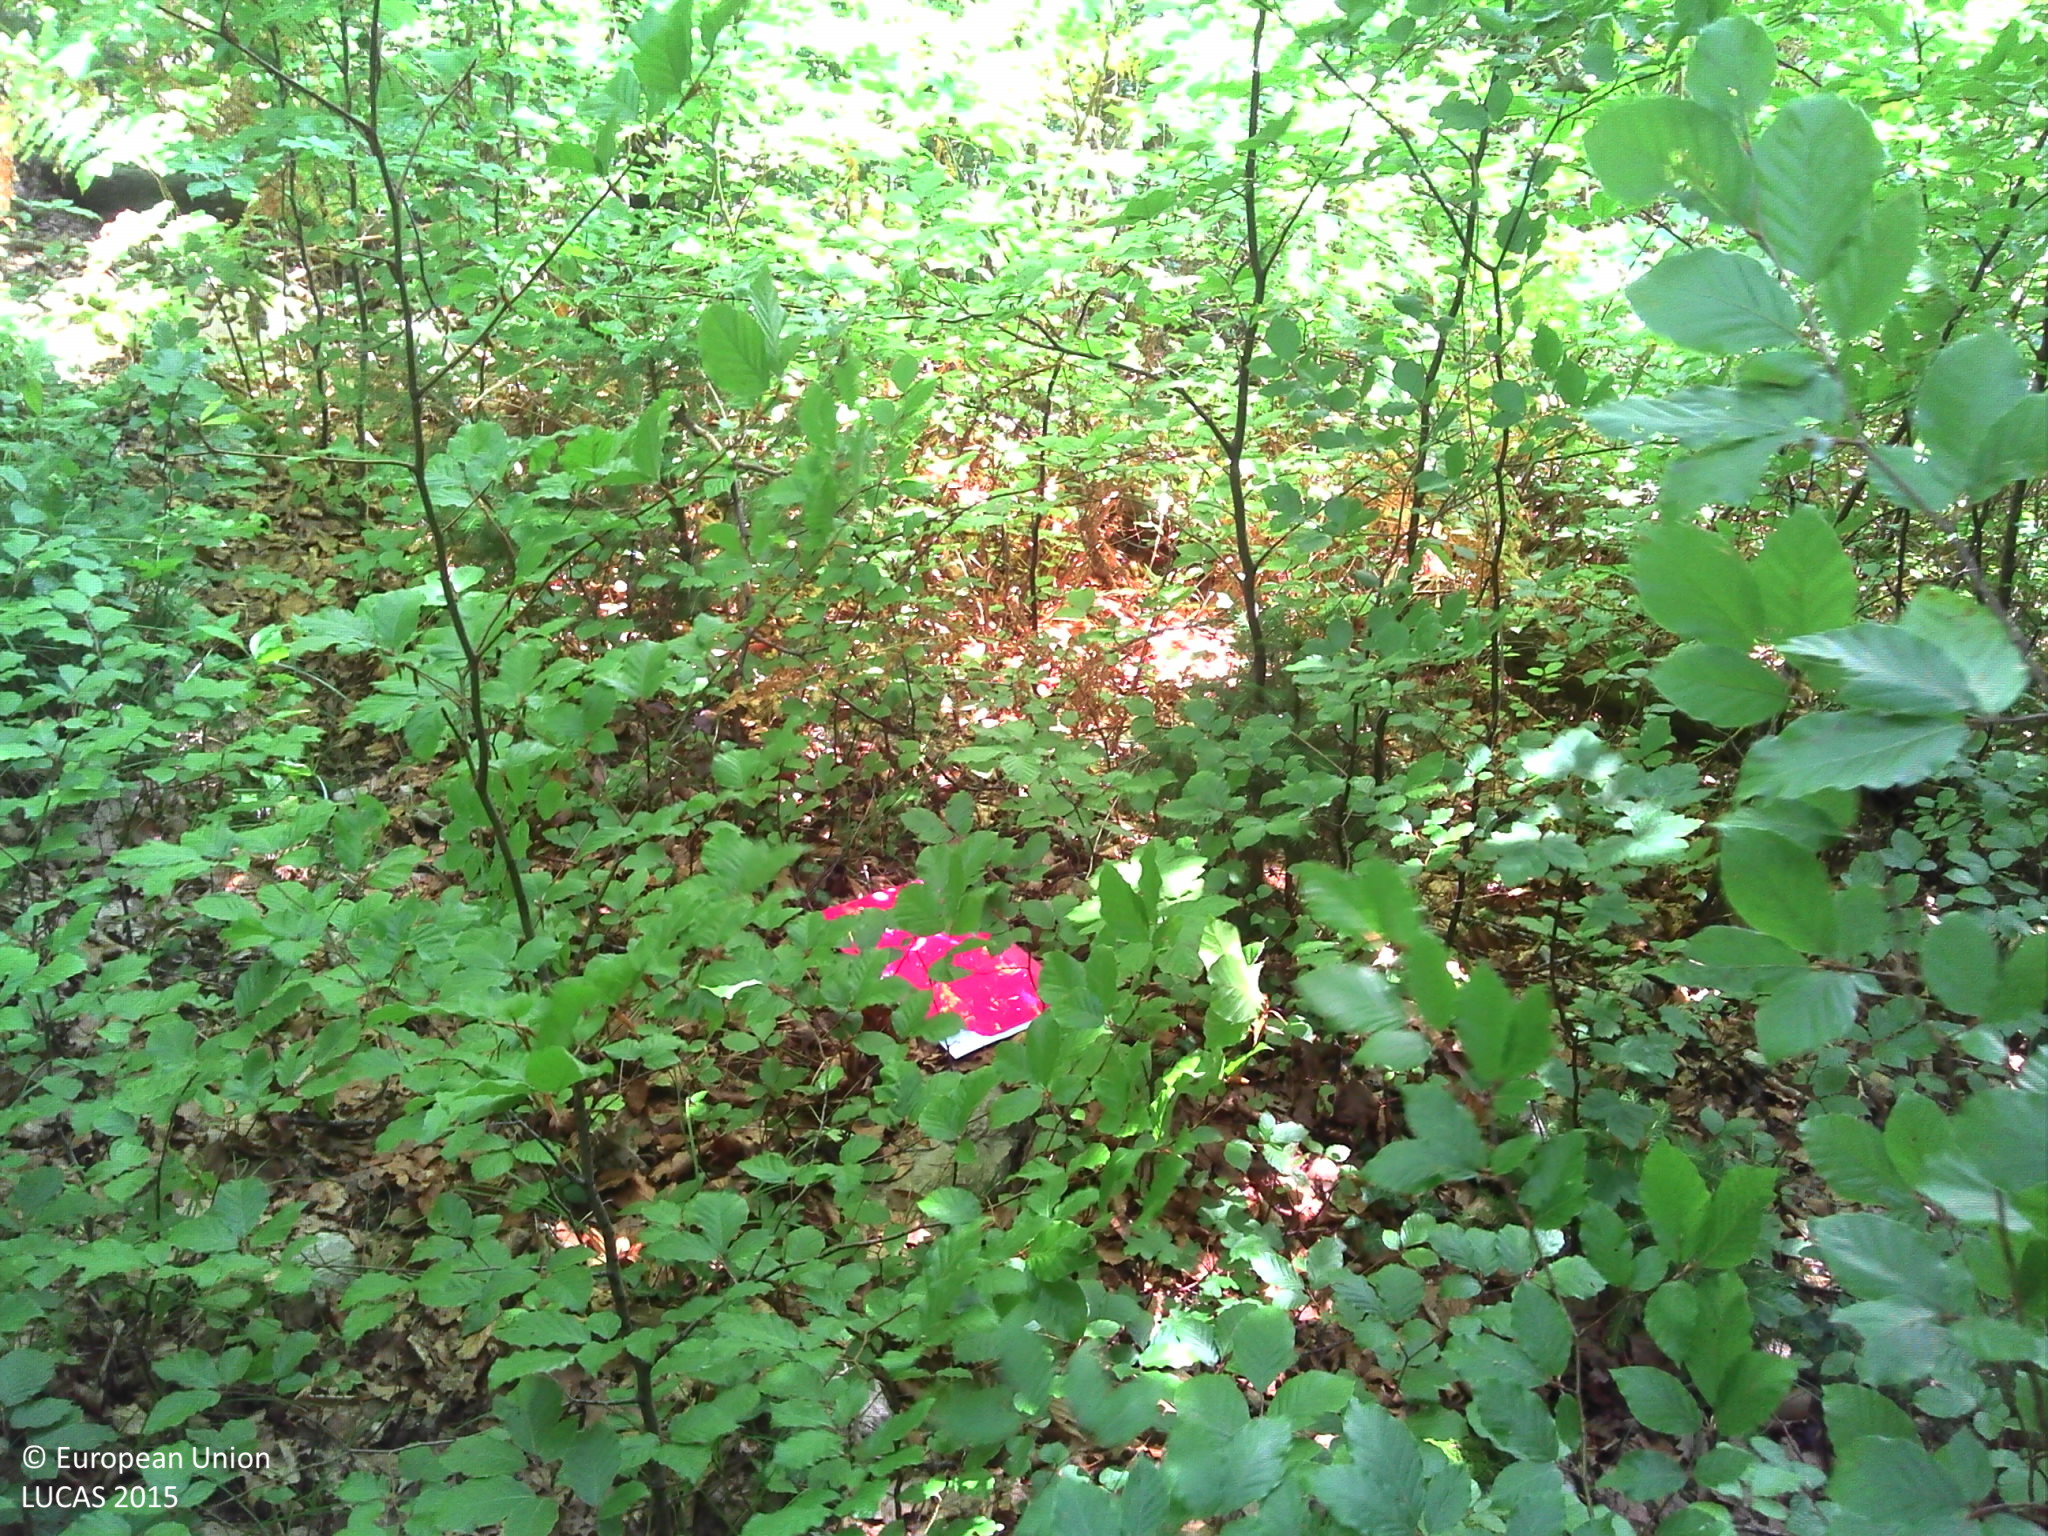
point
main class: Woodland
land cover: Pine dominated mixed woodland
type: beech forest
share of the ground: > 75 %
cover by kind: coniferous forest trees 40 %, broadleaved forest trees 35 %, herbaceous plants 20 %, lichens and mosses 5 %
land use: Forestry
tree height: > 5 m
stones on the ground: > 50 %
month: July
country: FR
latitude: 46.0930
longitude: 6.4209
